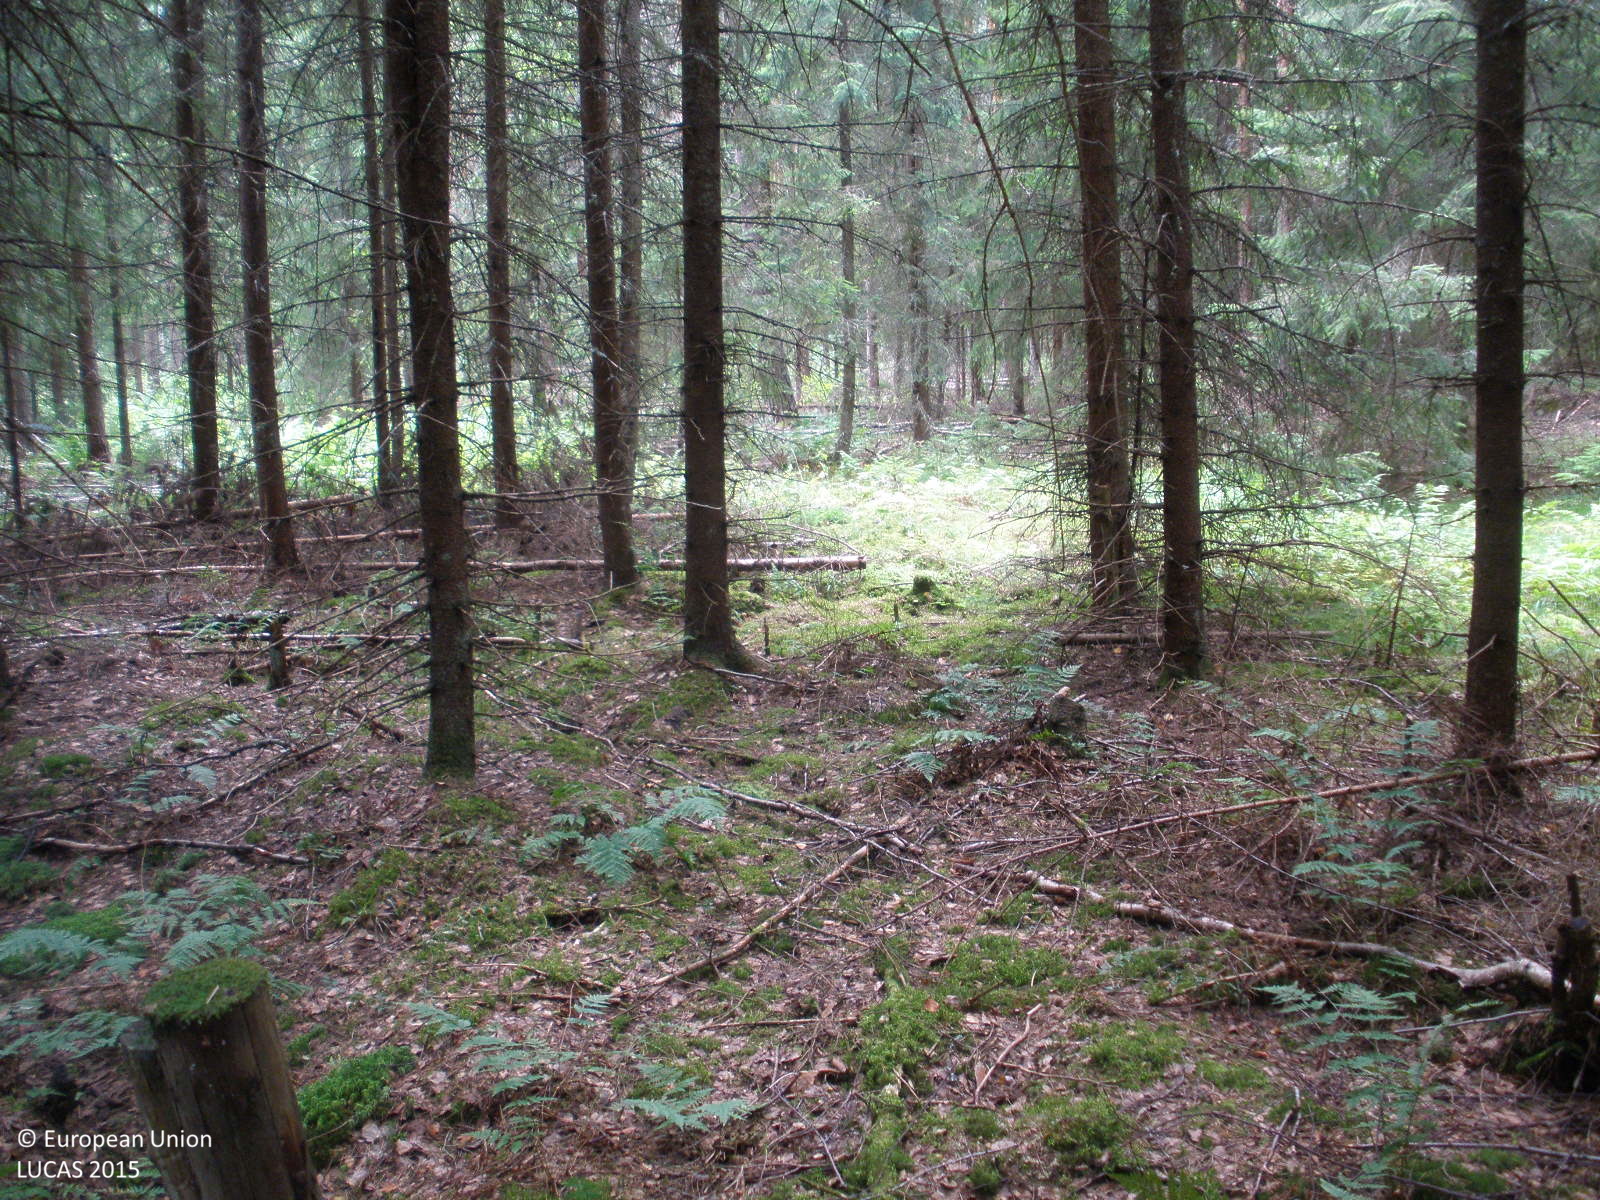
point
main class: Woodland
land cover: Spruce dominated coniferous woodland
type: boreal forest
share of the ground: > 75 %
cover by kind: coniferous forest trees 85 %, lichens and mosses 10 %, herbaceous plants 5 %
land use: Forestry
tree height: > 5 m
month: August
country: FI
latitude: 61.0692
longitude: 24.7659
